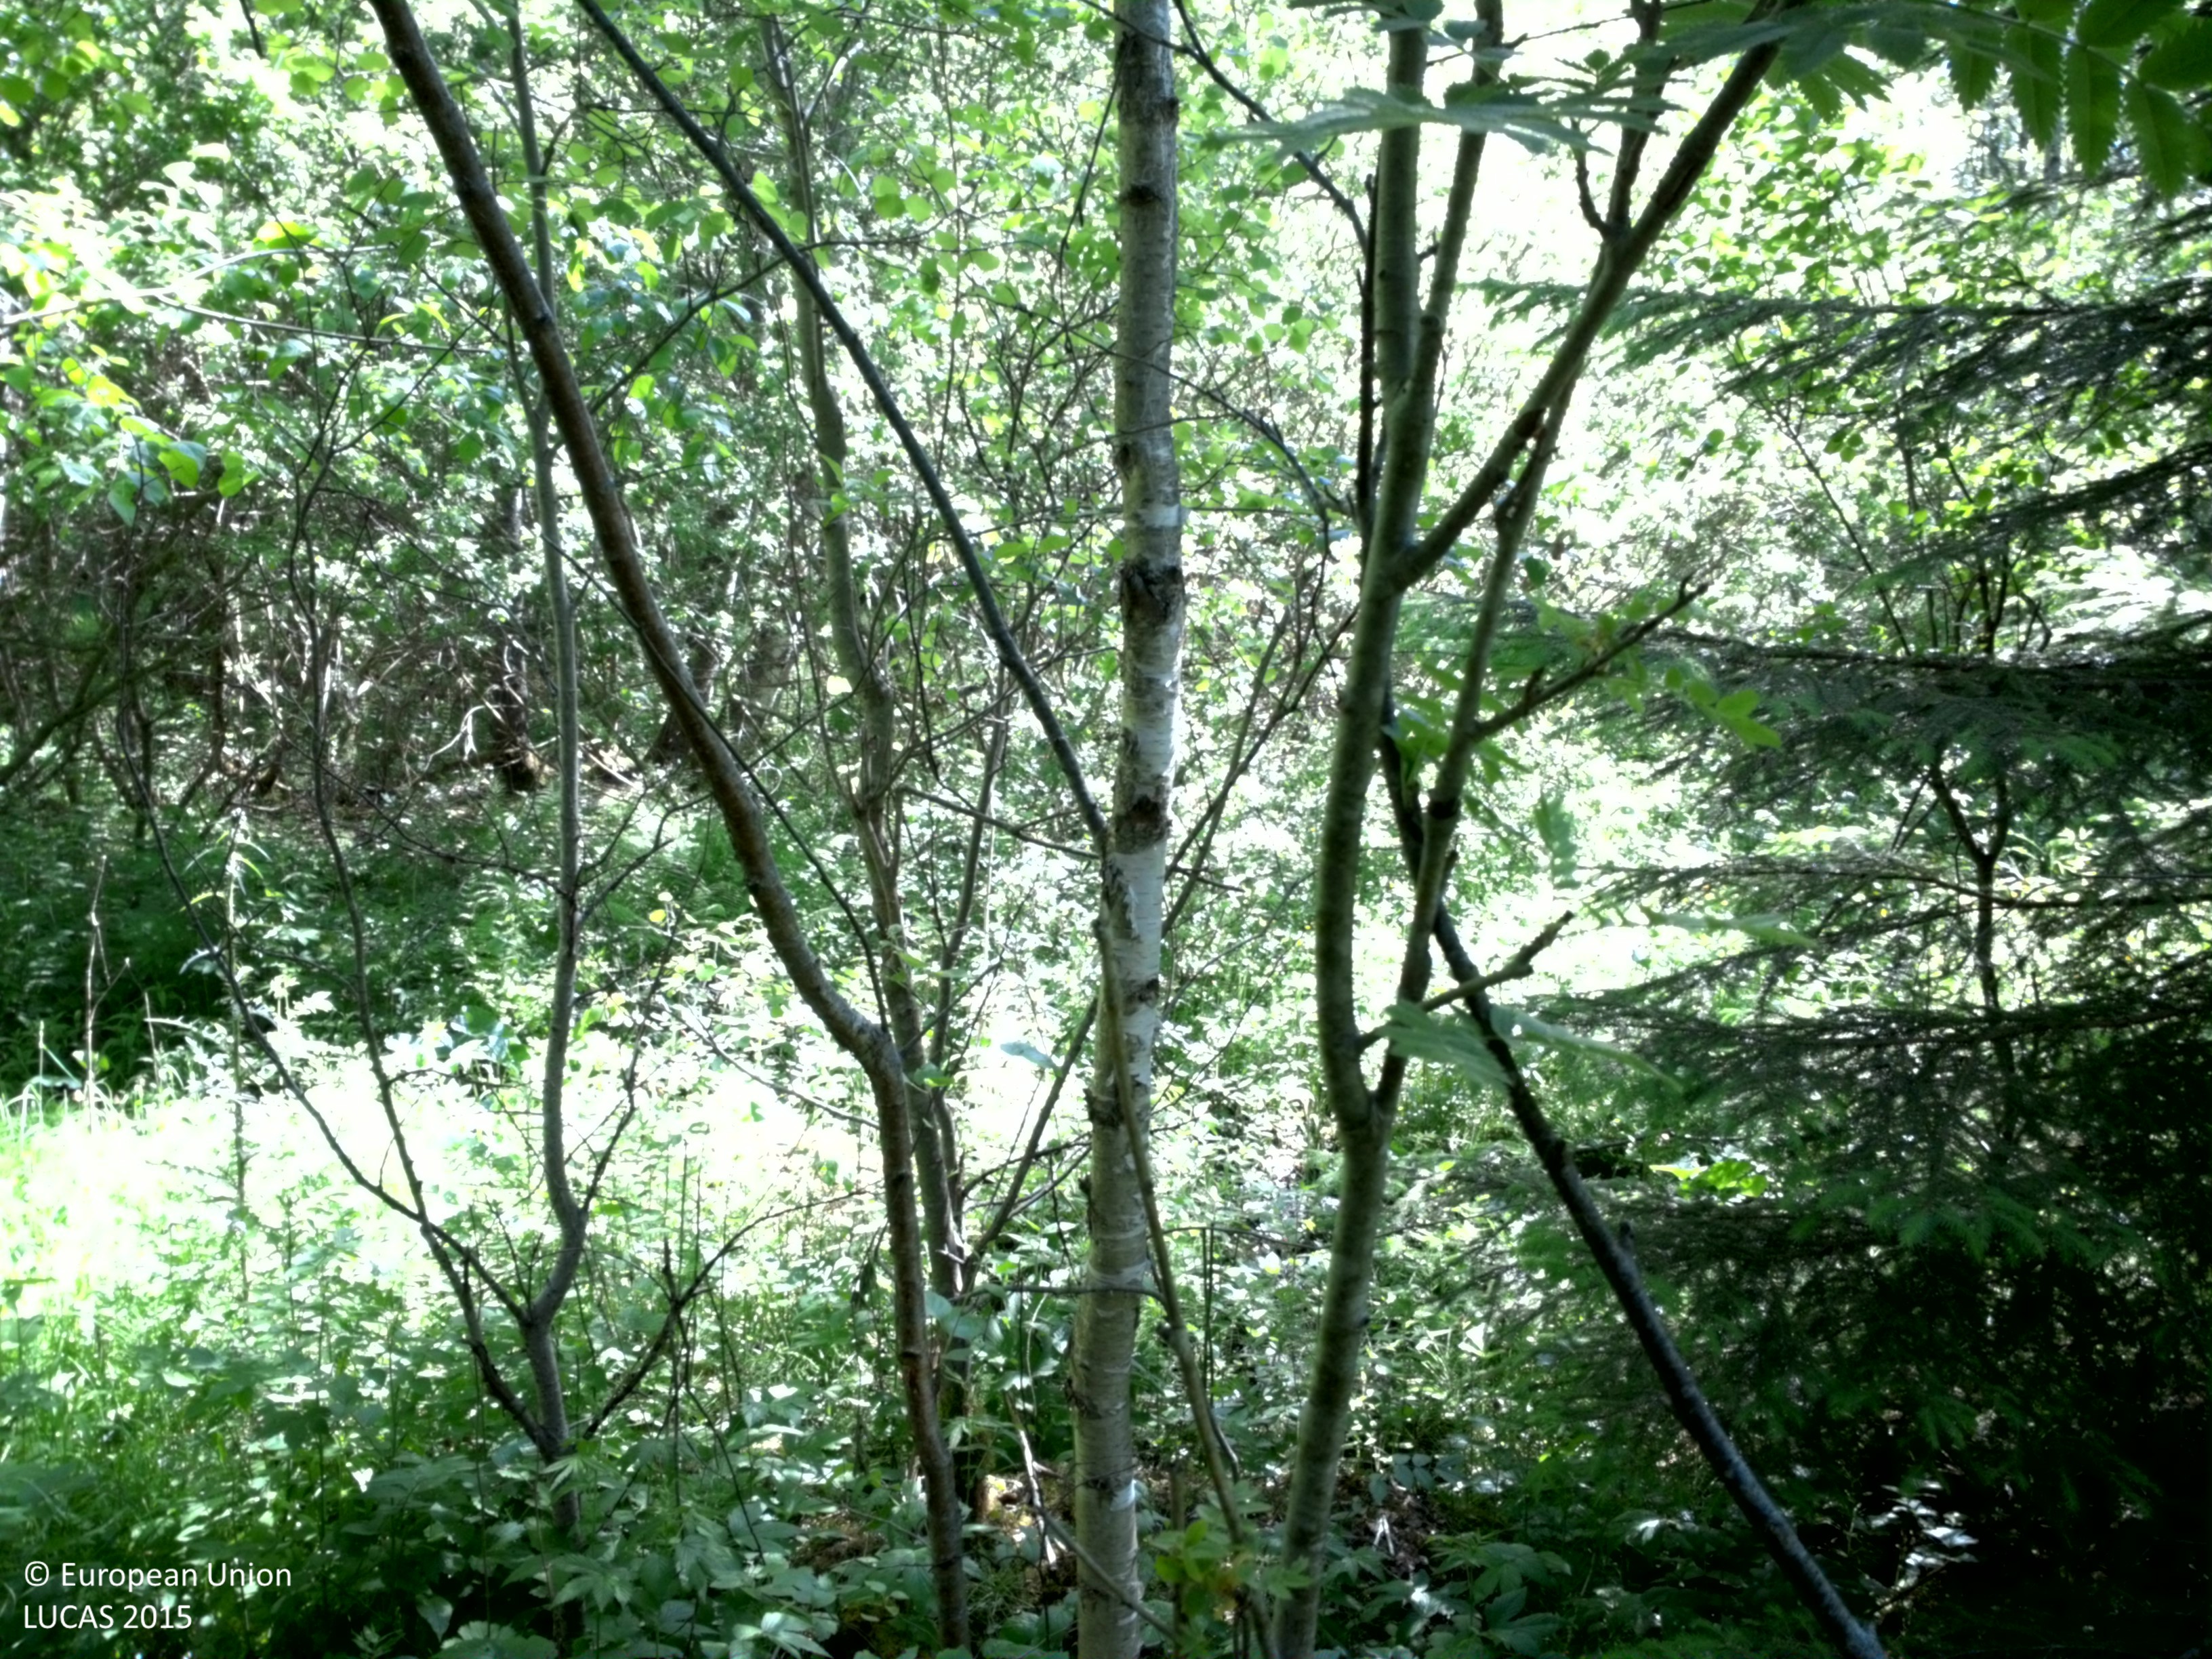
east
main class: Woodland
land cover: Broadleaved woodland
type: boreal forest
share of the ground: > 75 %
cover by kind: broadleaved forest trees 80 %, coniferous forest trees 10 %, herbaceous plants 10 %
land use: Forestry
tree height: > 5 m
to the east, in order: Broadleaved woodland; Rivers and streams; Broadleaved woodland; Grassland with sparse tree/shrub cover; Broadleaved woodland; Artificial constructions in urban areas; Broadleaved woodland; Ditches and canals; Grass margins; Paved roads, cycling and walking lanes; Grass margins; Ditches and canals; Broadleaved woodland; Ditches and canals; Broadleaved woodland; Spruce dominated mixed woodland; Spruce dominated coniferous woodland
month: June
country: SE
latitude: 58.6311
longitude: 14.4885
